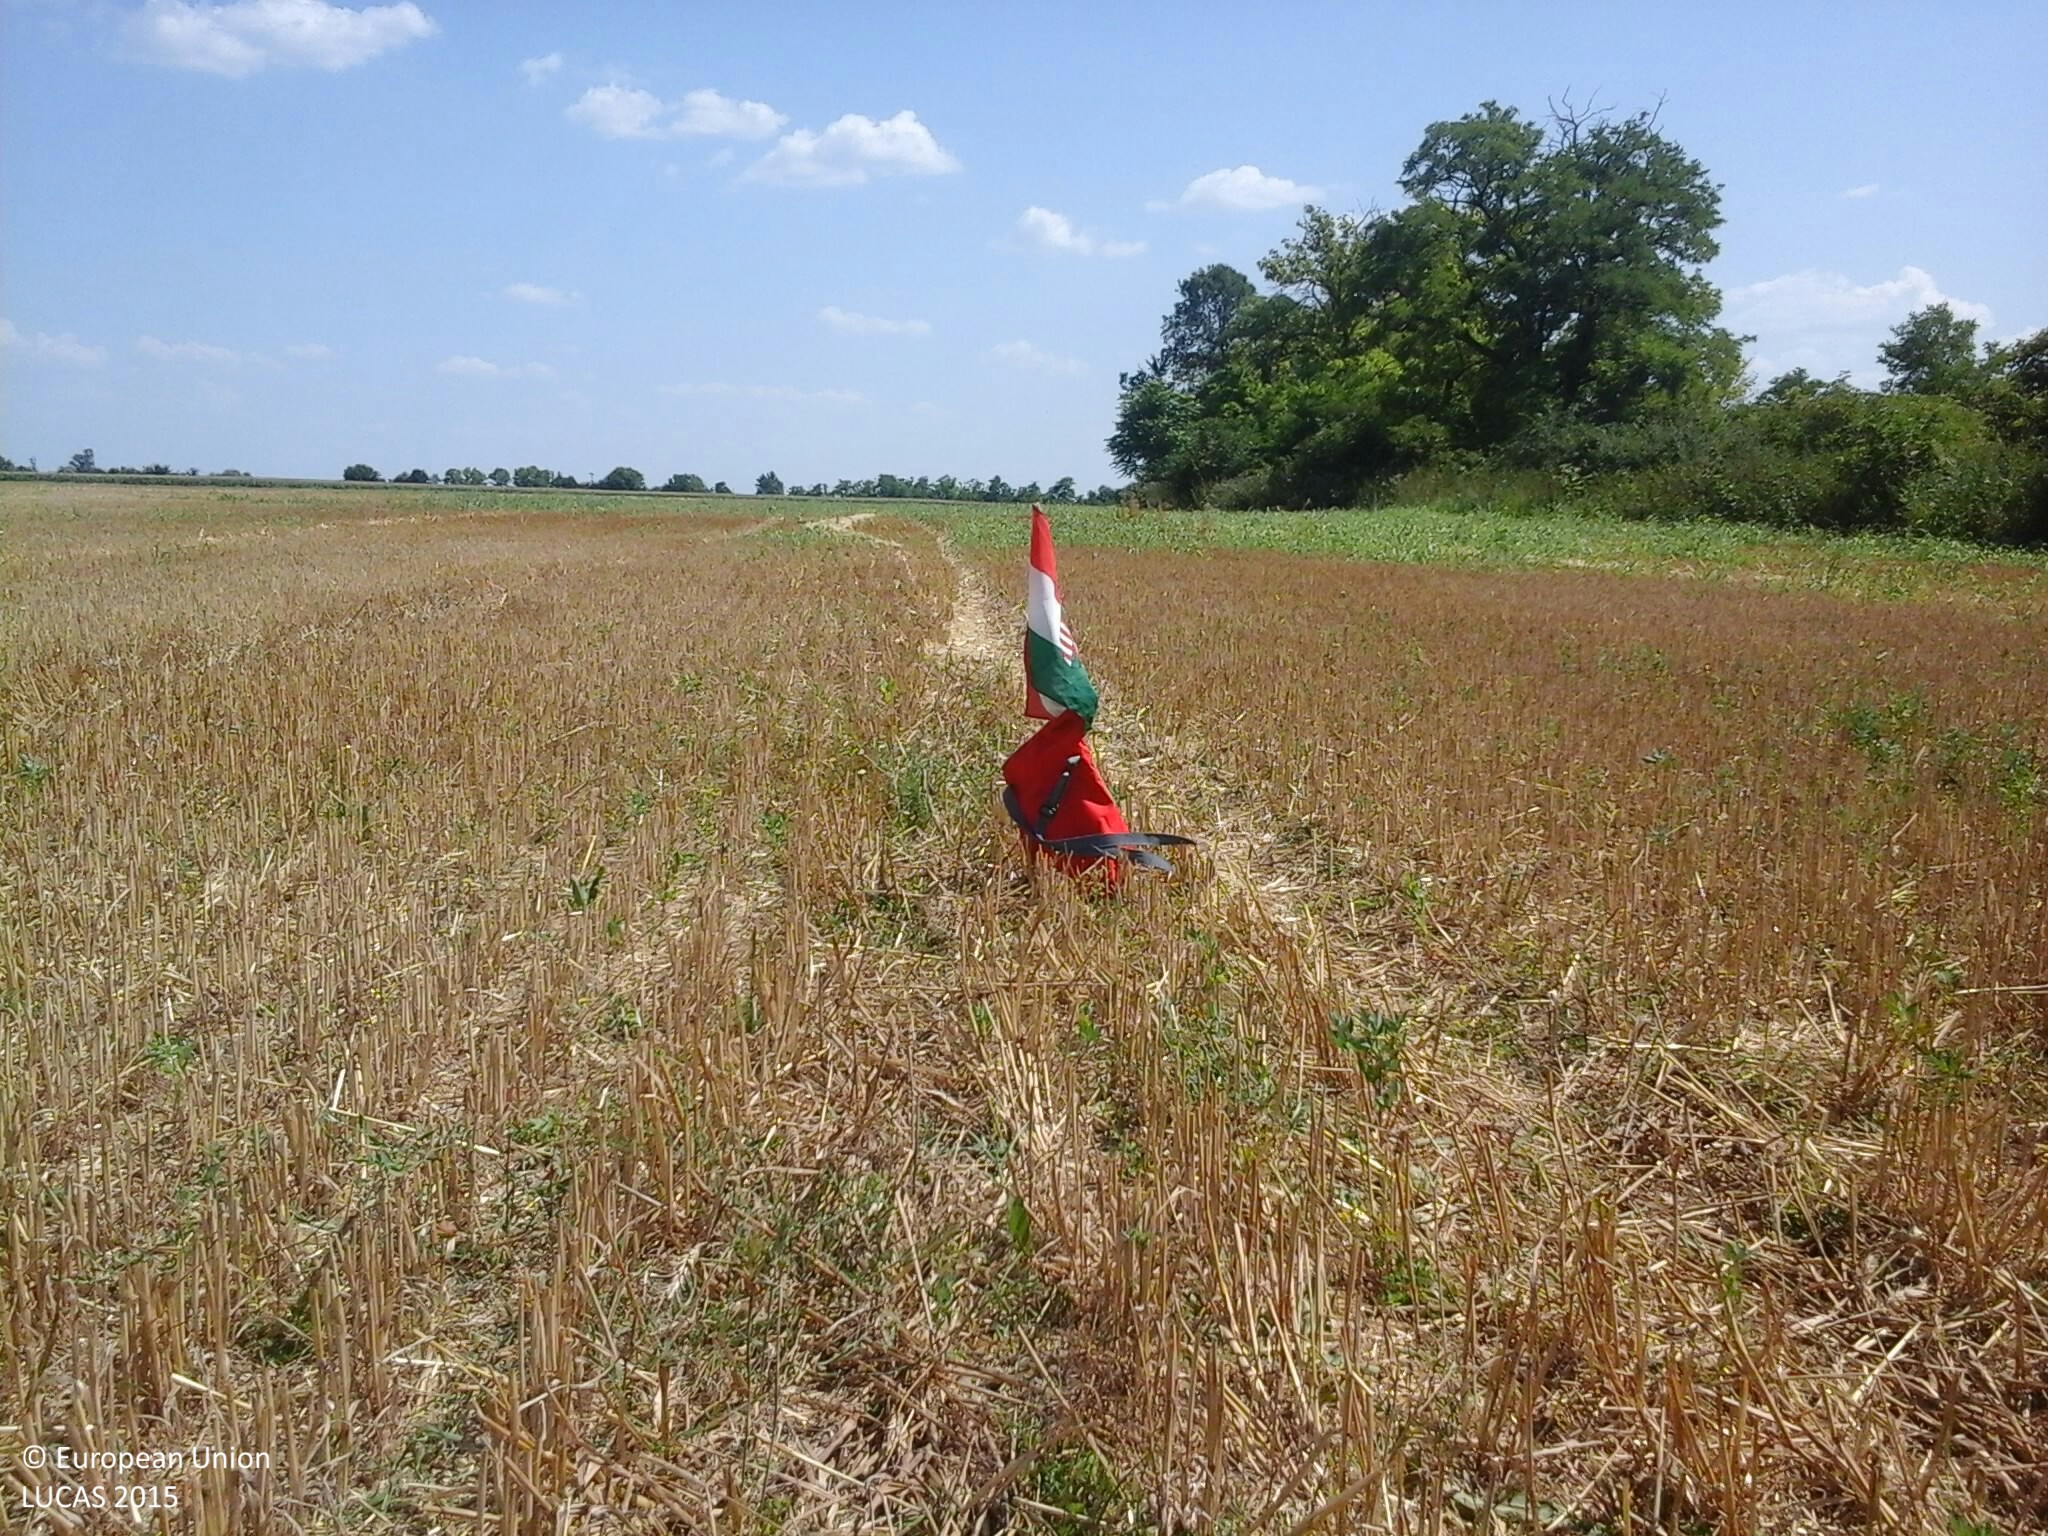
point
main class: Cropland
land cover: Common wheat
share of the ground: 25 - 50 %
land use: Agriculture (excluding fallow land and kitchen gardens)
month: July
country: HU
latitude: 47.0406
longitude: 18.3158
